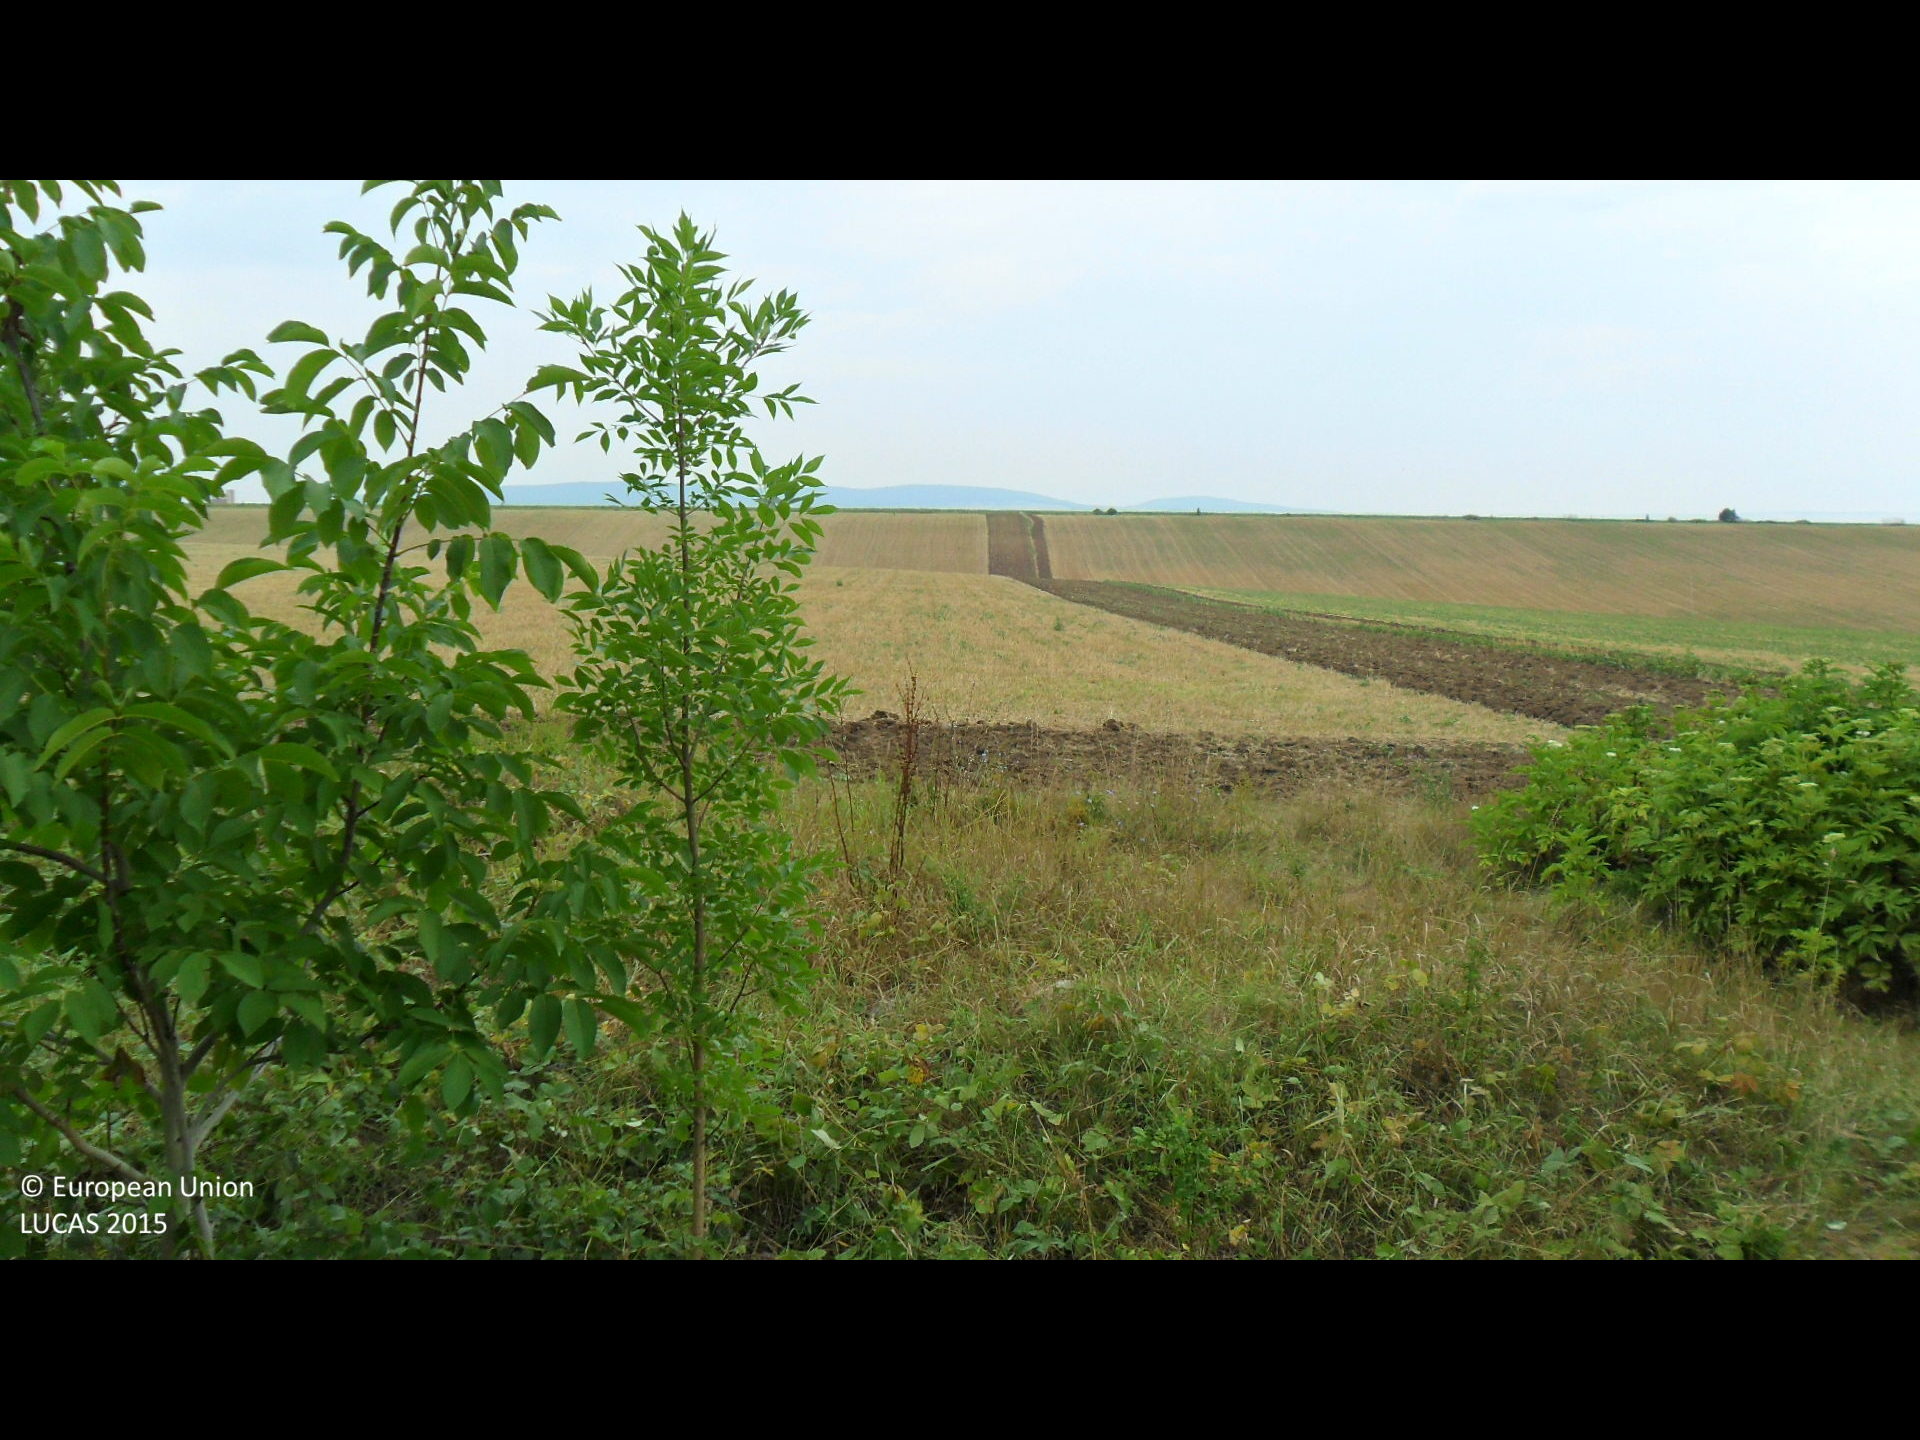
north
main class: Shrubland
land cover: Shrubland with sparse tree cover
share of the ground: > 75 %
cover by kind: shrubs 95 %, broadleaved forest trees 5 %
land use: Semi-natural and natural areas not in use
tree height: < 5 m
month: July
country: BG
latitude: 43.3537
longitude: 26.2469
